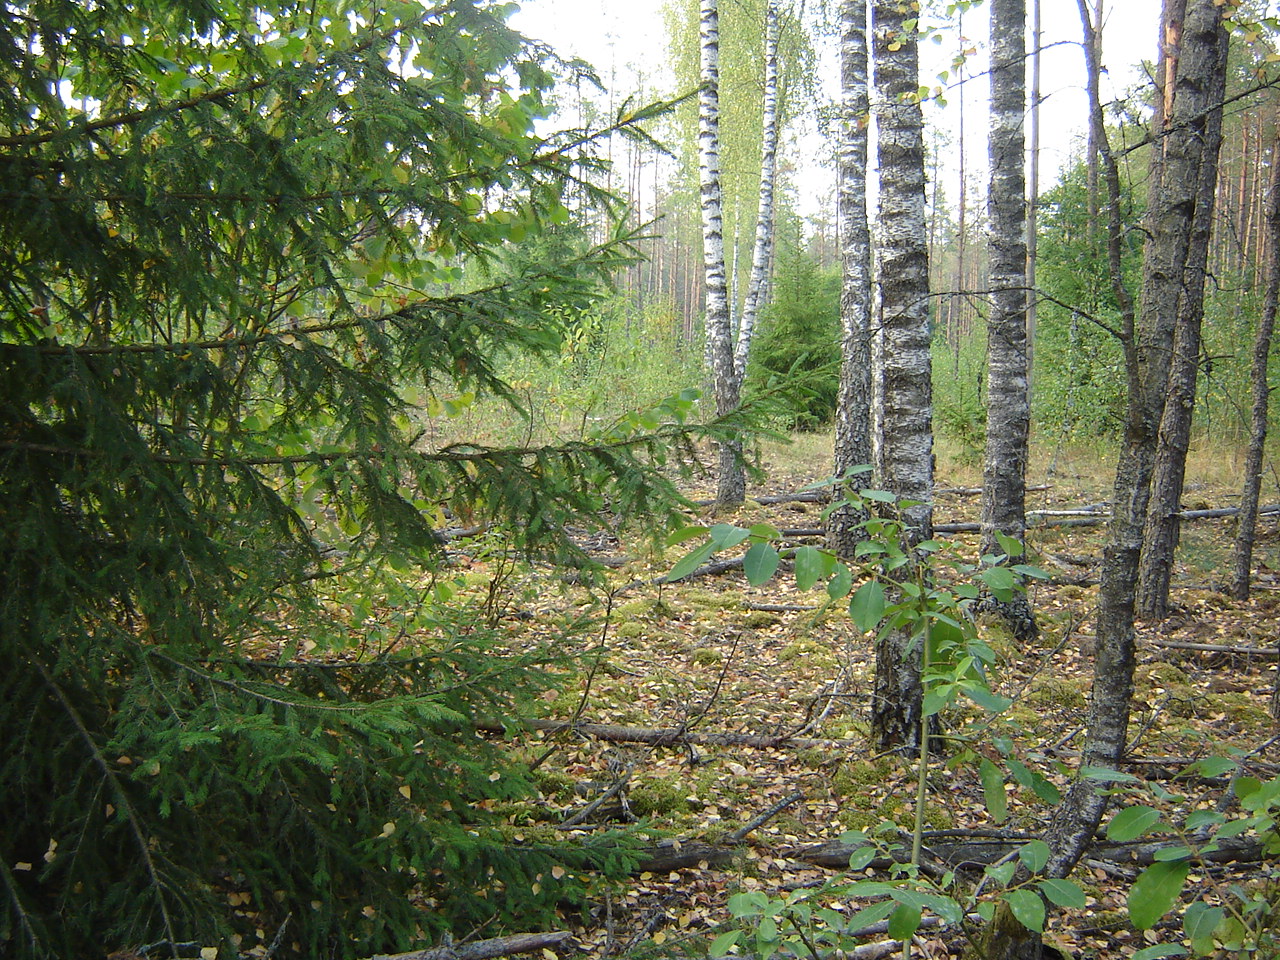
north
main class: Woodland
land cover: Pine dominated mixed woodland
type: hemiboreal forest and nemoral coniferous forest and mixed broadleaved-coniferous forest
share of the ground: > 75 %
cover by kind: coniferous forest trees 55 %, broadleaved forest trees 30 %, lichens and mosses 15 %
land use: Forestry
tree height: > 5 m
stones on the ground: < 10 %
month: September
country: LT
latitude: 54.4292
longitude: 24.7688
